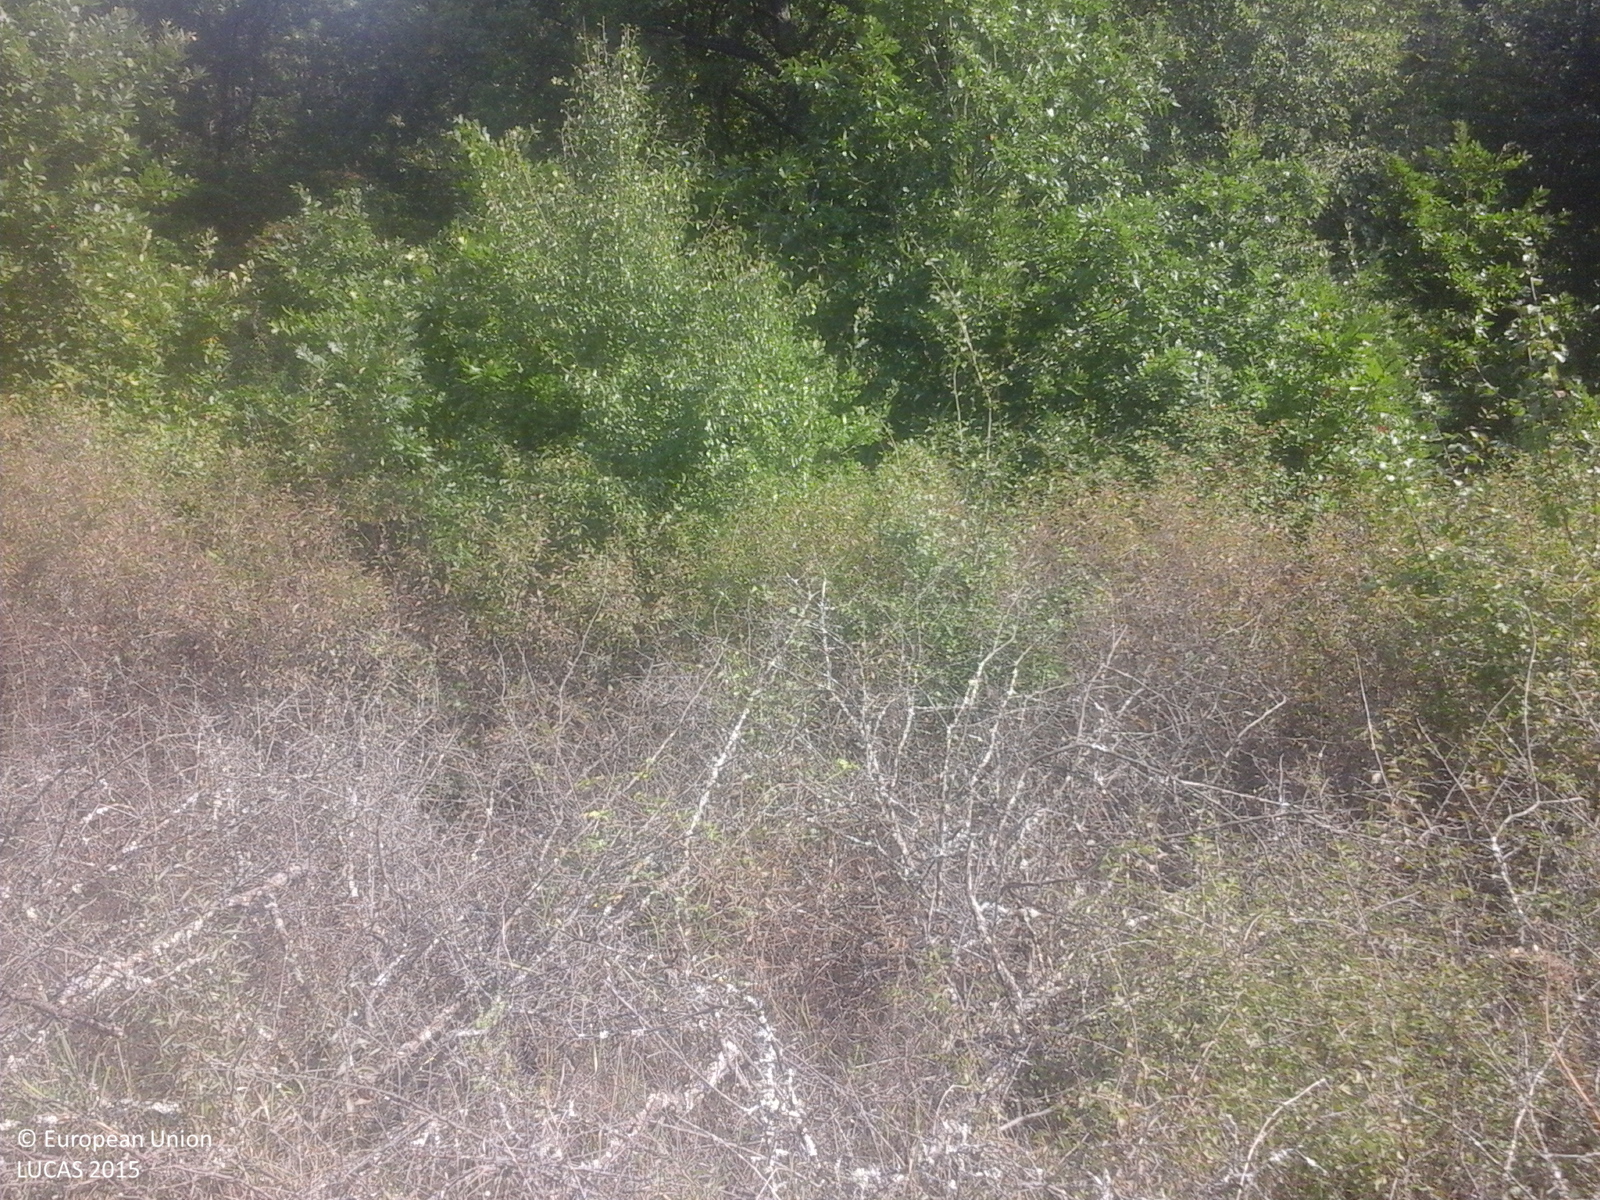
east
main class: Grassland
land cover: Spontaneously vegetated surfaces
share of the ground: > 75 %
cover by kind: herbaceous plants 100 %
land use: Semi-natural and natural areas not in use
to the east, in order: Spontaneously vegetated surfaces; Shrubland with sparse tree cover; Broadleaved woodland
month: September
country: RO
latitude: 46.9316
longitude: 23.2130
